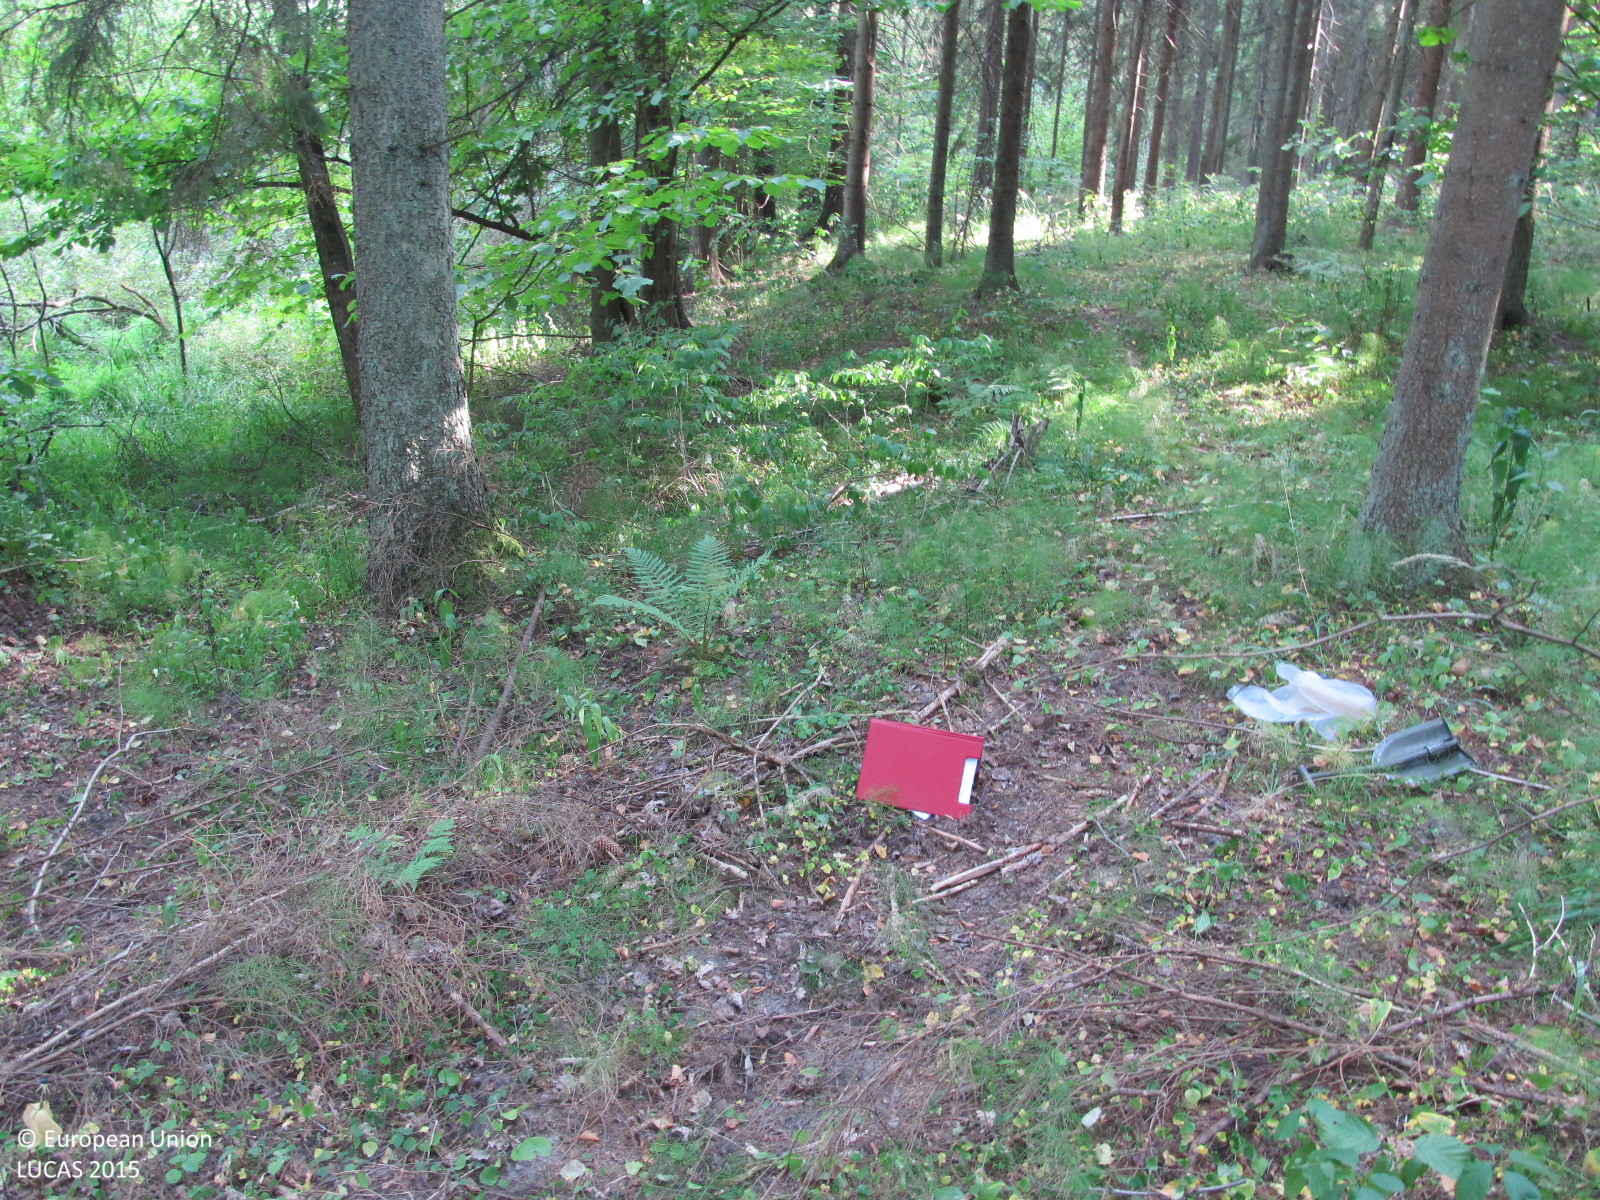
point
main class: Woodland
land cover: Spruce dominated mixed woodland
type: hemiboreal forest and nemoral coniferous forest and mixed broadleaved-coniferous forest
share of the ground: 50 - 75 %
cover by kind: coniferous forest trees 45 %, broadleaved forest trees 25 %, herbaceous plants 20 %, shrubs 10 %
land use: Forestry
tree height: > 5 m
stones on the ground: < 10 %
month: August
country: LT
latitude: 55.7574
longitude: 23.0243
